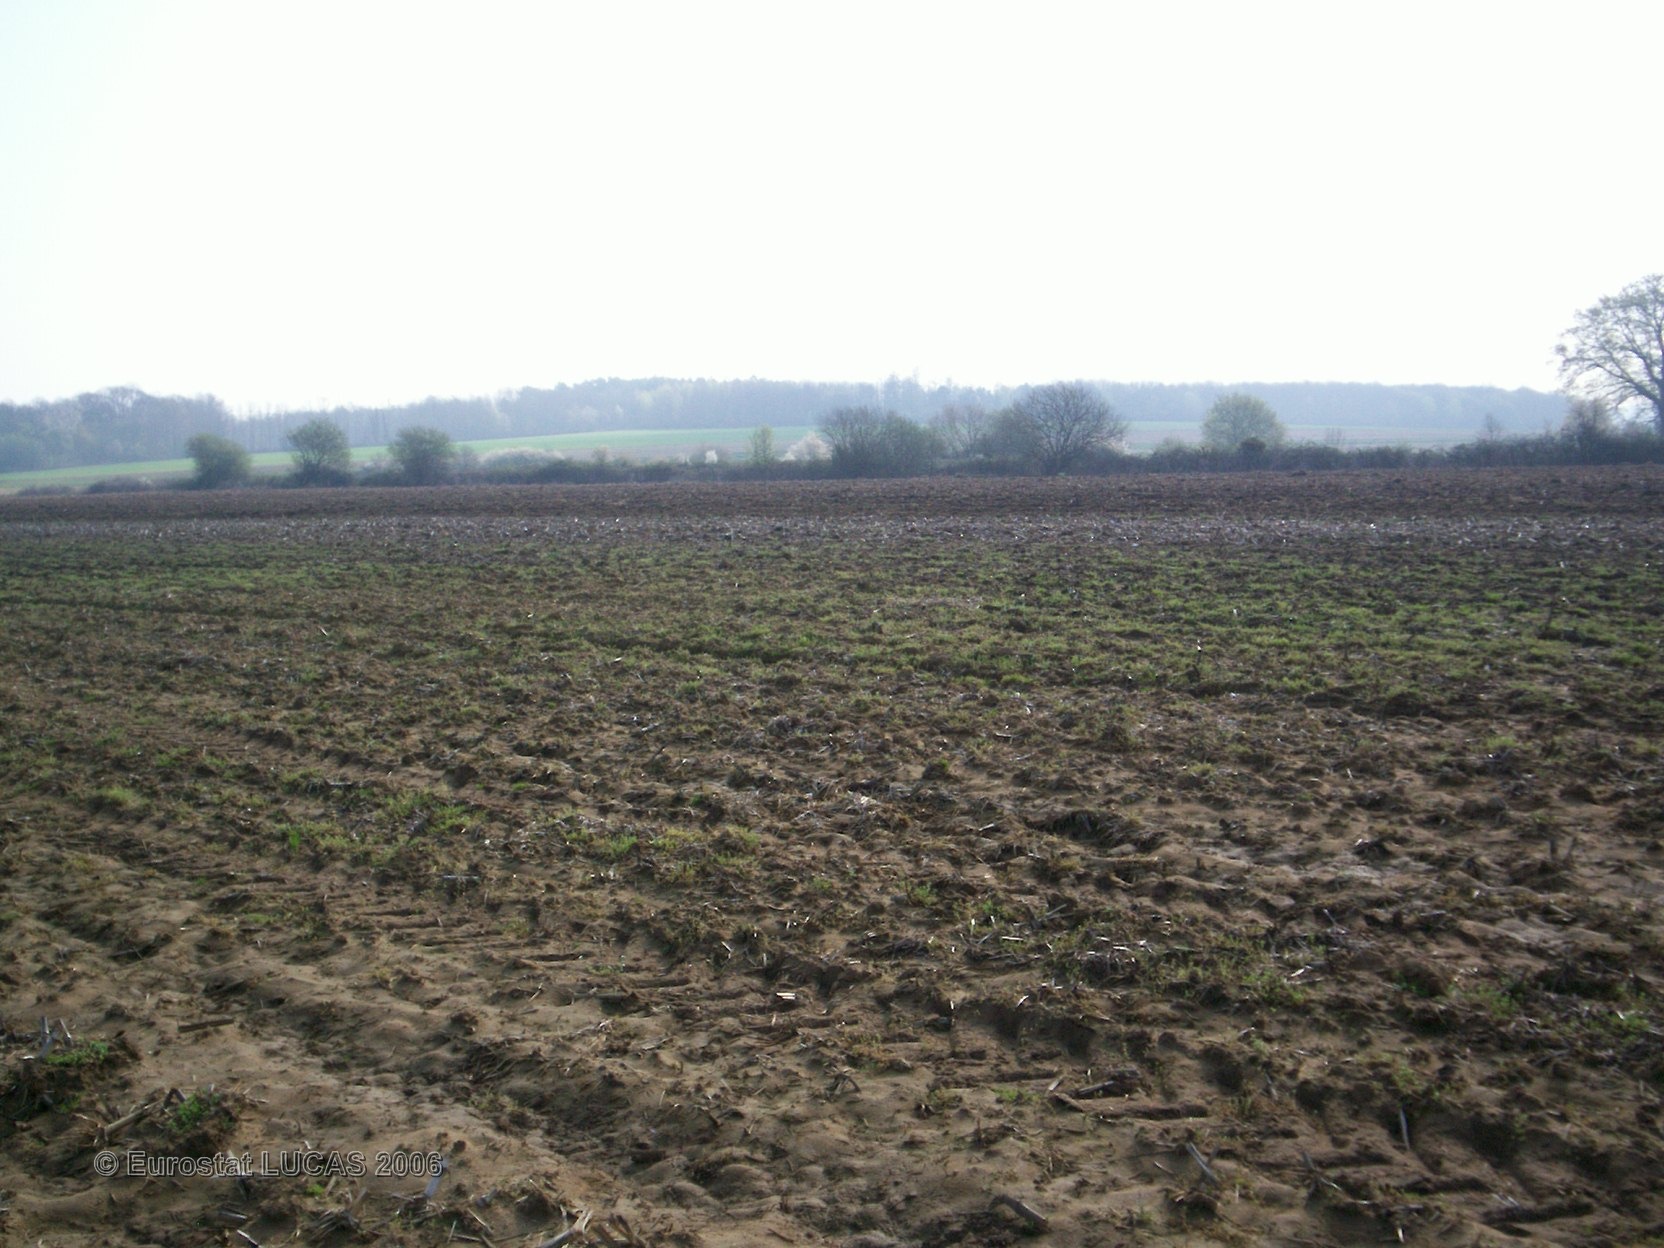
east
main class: Cropland
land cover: Maize
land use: Agriculture (excluding fallow land and kitchen gardens)
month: May
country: FR
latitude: 48.0736
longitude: 0.3789
